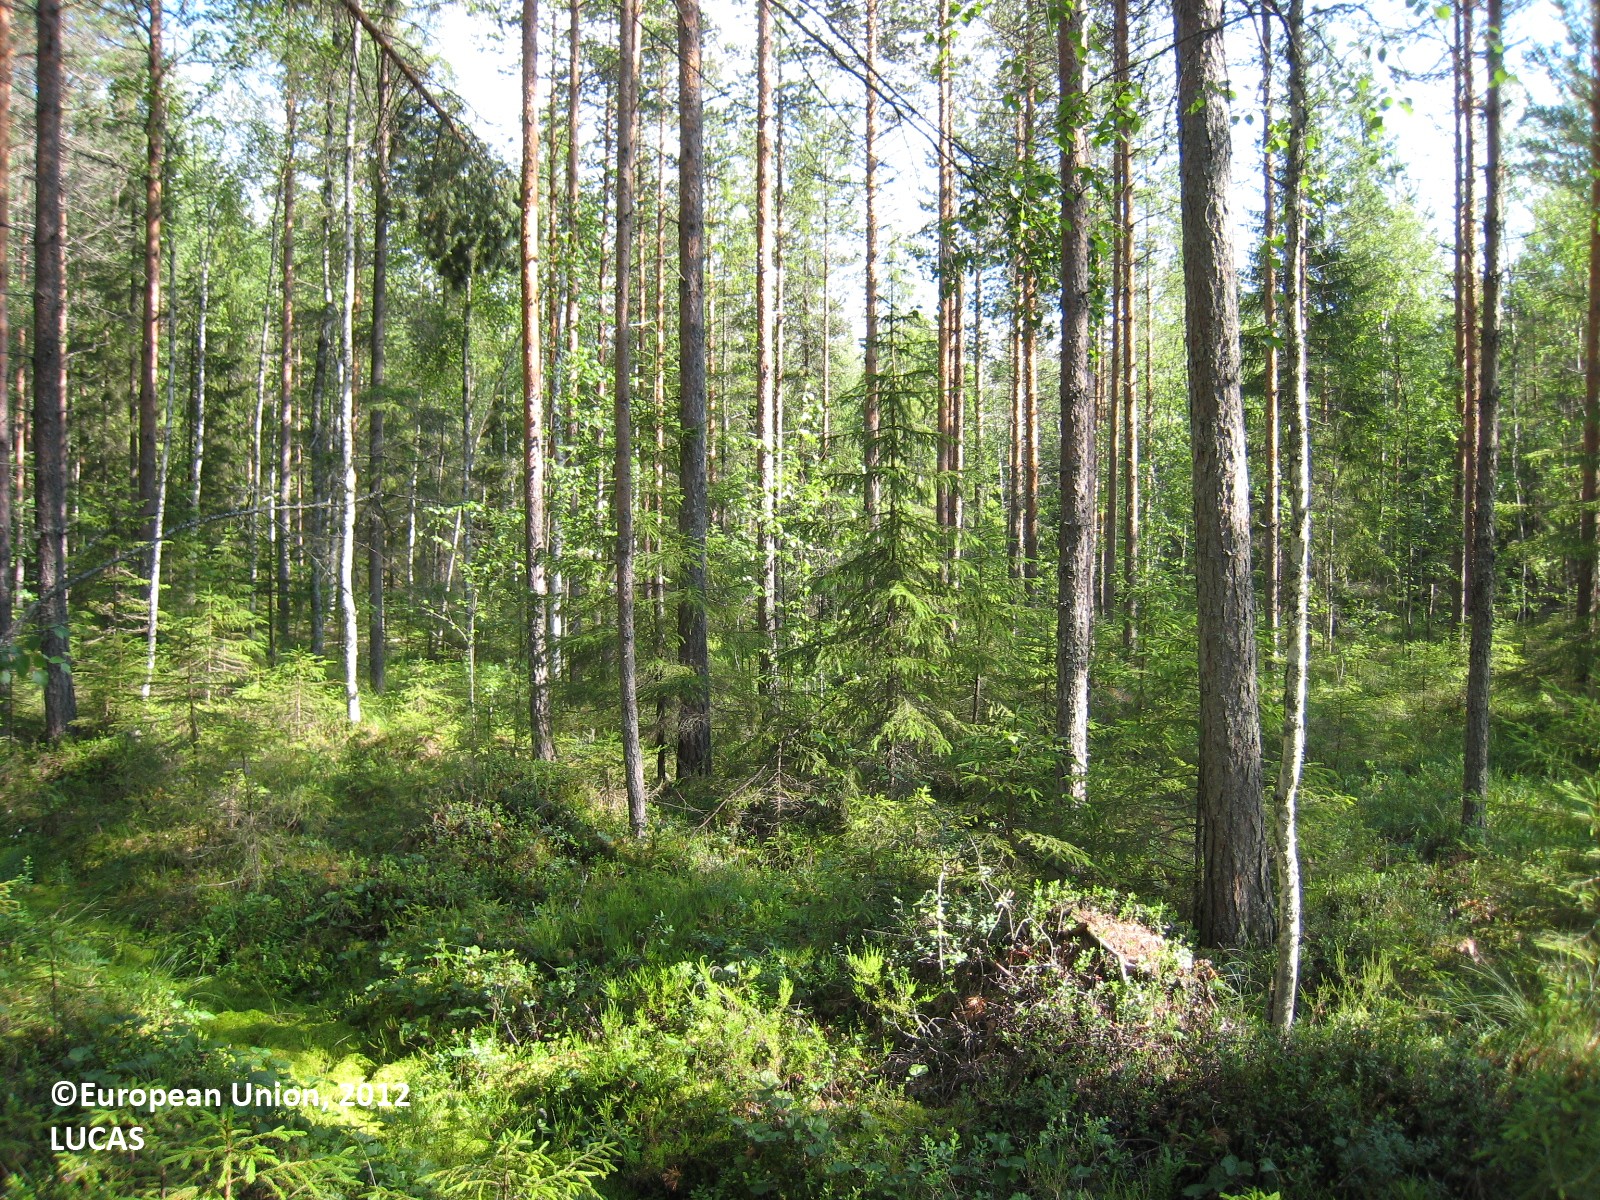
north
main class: Woodland
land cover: Pine dominated mixed woodland
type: mire and swamp forests
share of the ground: 50 - 75 %
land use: Forestry
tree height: > 5 m
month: July
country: FI
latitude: 61.7895
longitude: 27.0961
